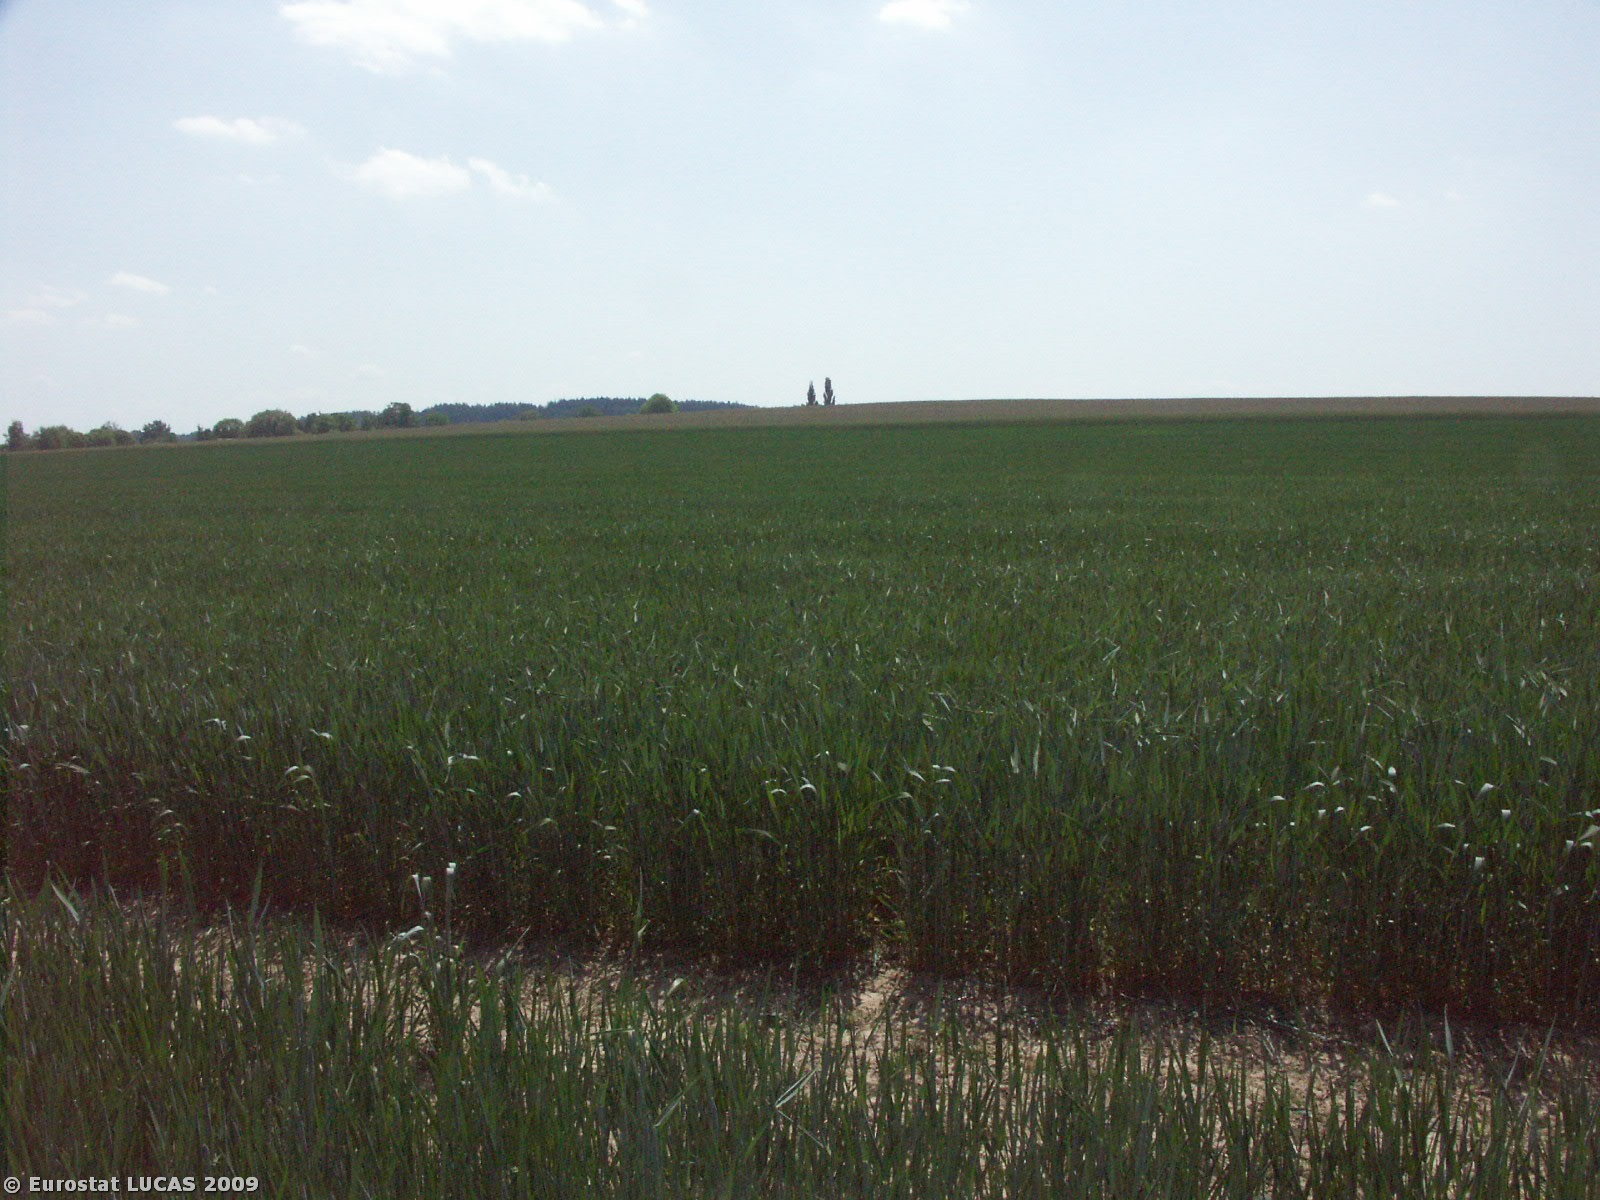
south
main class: Cropland
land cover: Common wheat
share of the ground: > 75 %
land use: Agriculture (excluding fallow land and kitchen gardens)
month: May
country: CZ
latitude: 49.0427
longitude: 14.6940
